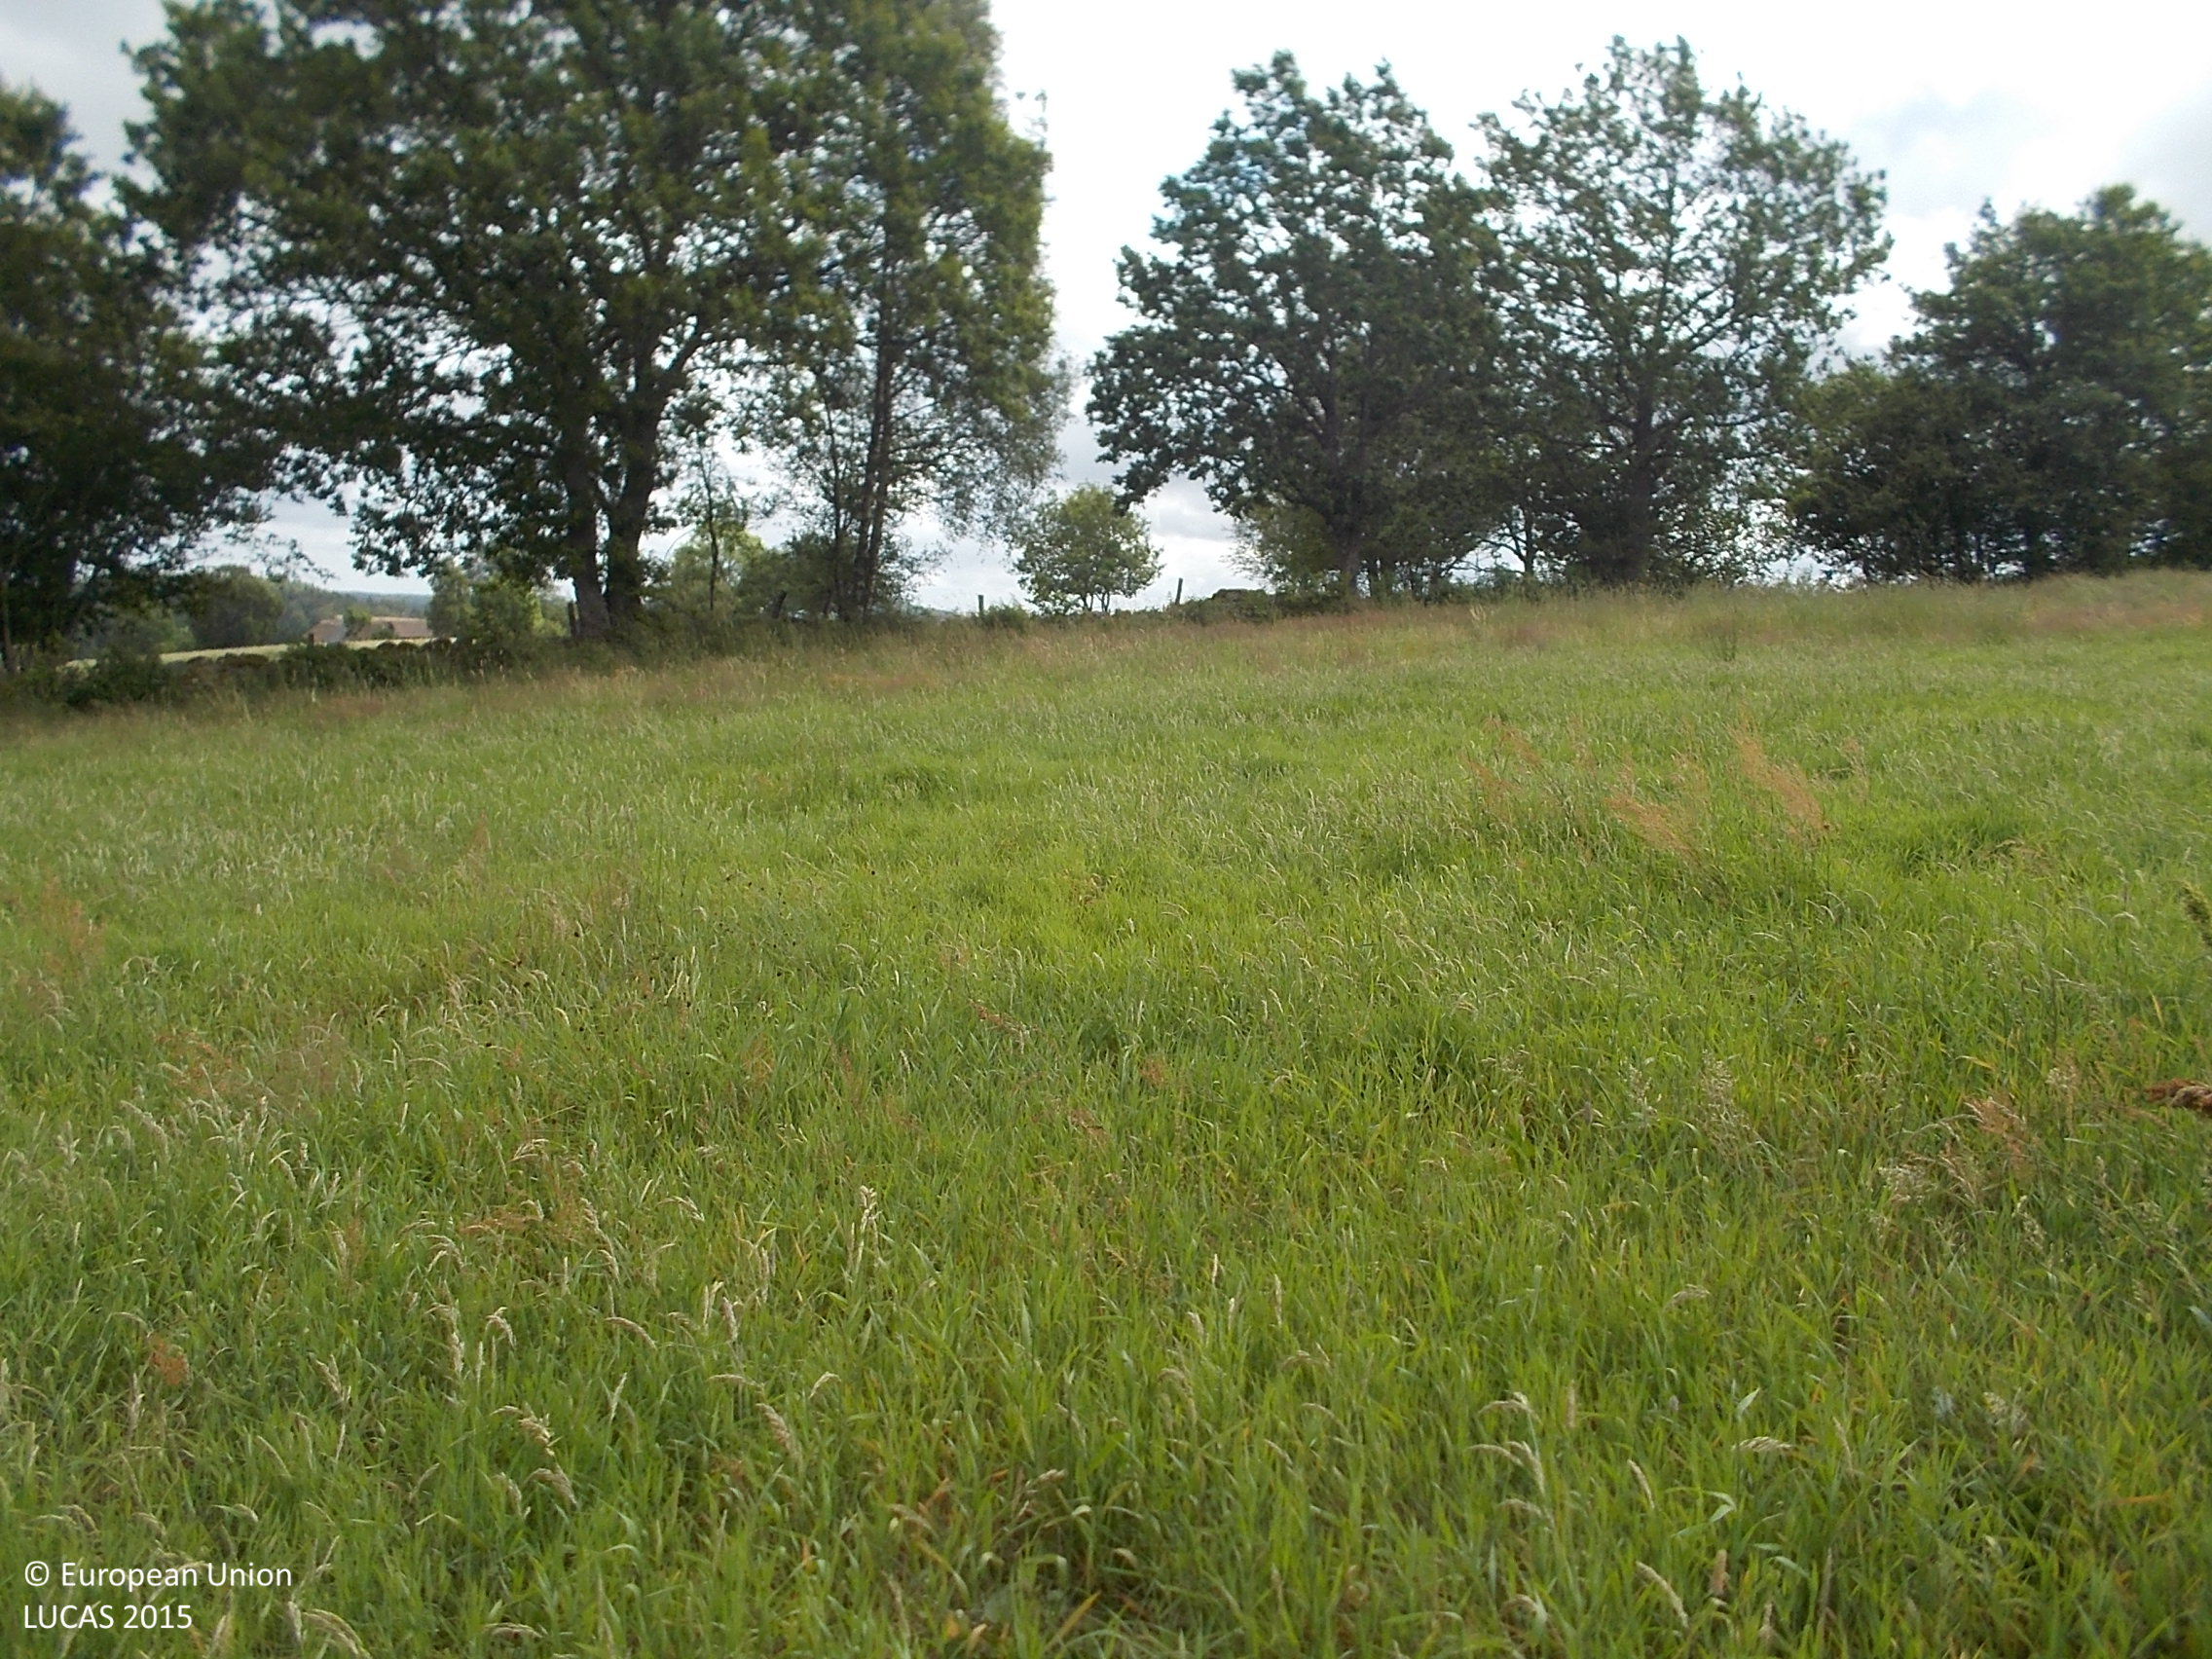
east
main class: Grassland
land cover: Grassland without tree/shrub cover
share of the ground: > 75 %
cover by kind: herbaceous plants 100 %
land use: Agriculture (excluding fallow land and kitchen gardens)
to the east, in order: Grassland without tree/shrub cover; Groves; Dry stone walls; Fences; Grassland without tree/shrub cover; Dry stone walls; Fences; Single bushes/trees; Grass margins; Tracks; Grassland without tree/shrub cover; Fences; Grassland without tree/shrub cover; Fences; Grassland without tree/shrub cover
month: July
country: SE
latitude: 57.4266
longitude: 12.2781
